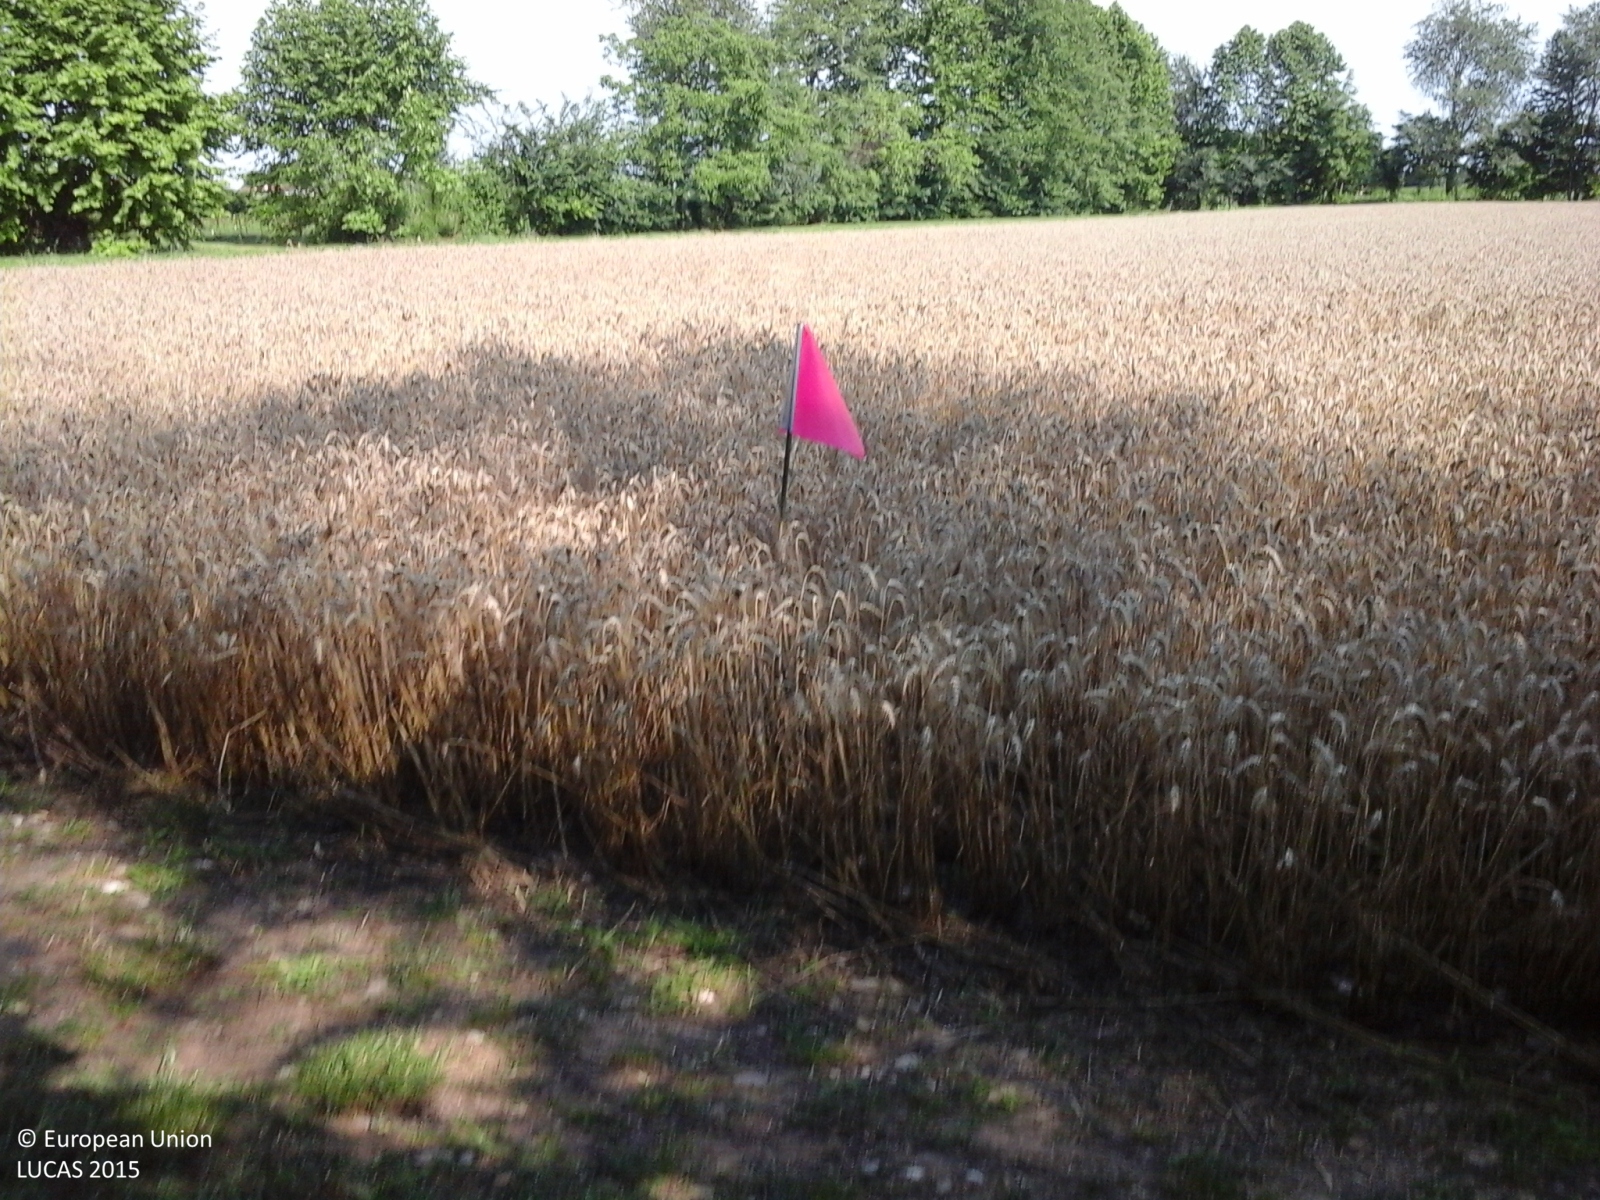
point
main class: Cropland
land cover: Common wheat
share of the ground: > 75 %
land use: Agriculture (excluding fallow land and kitchen gardens)
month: June
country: IT
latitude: 45.8910
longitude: 12.4324
